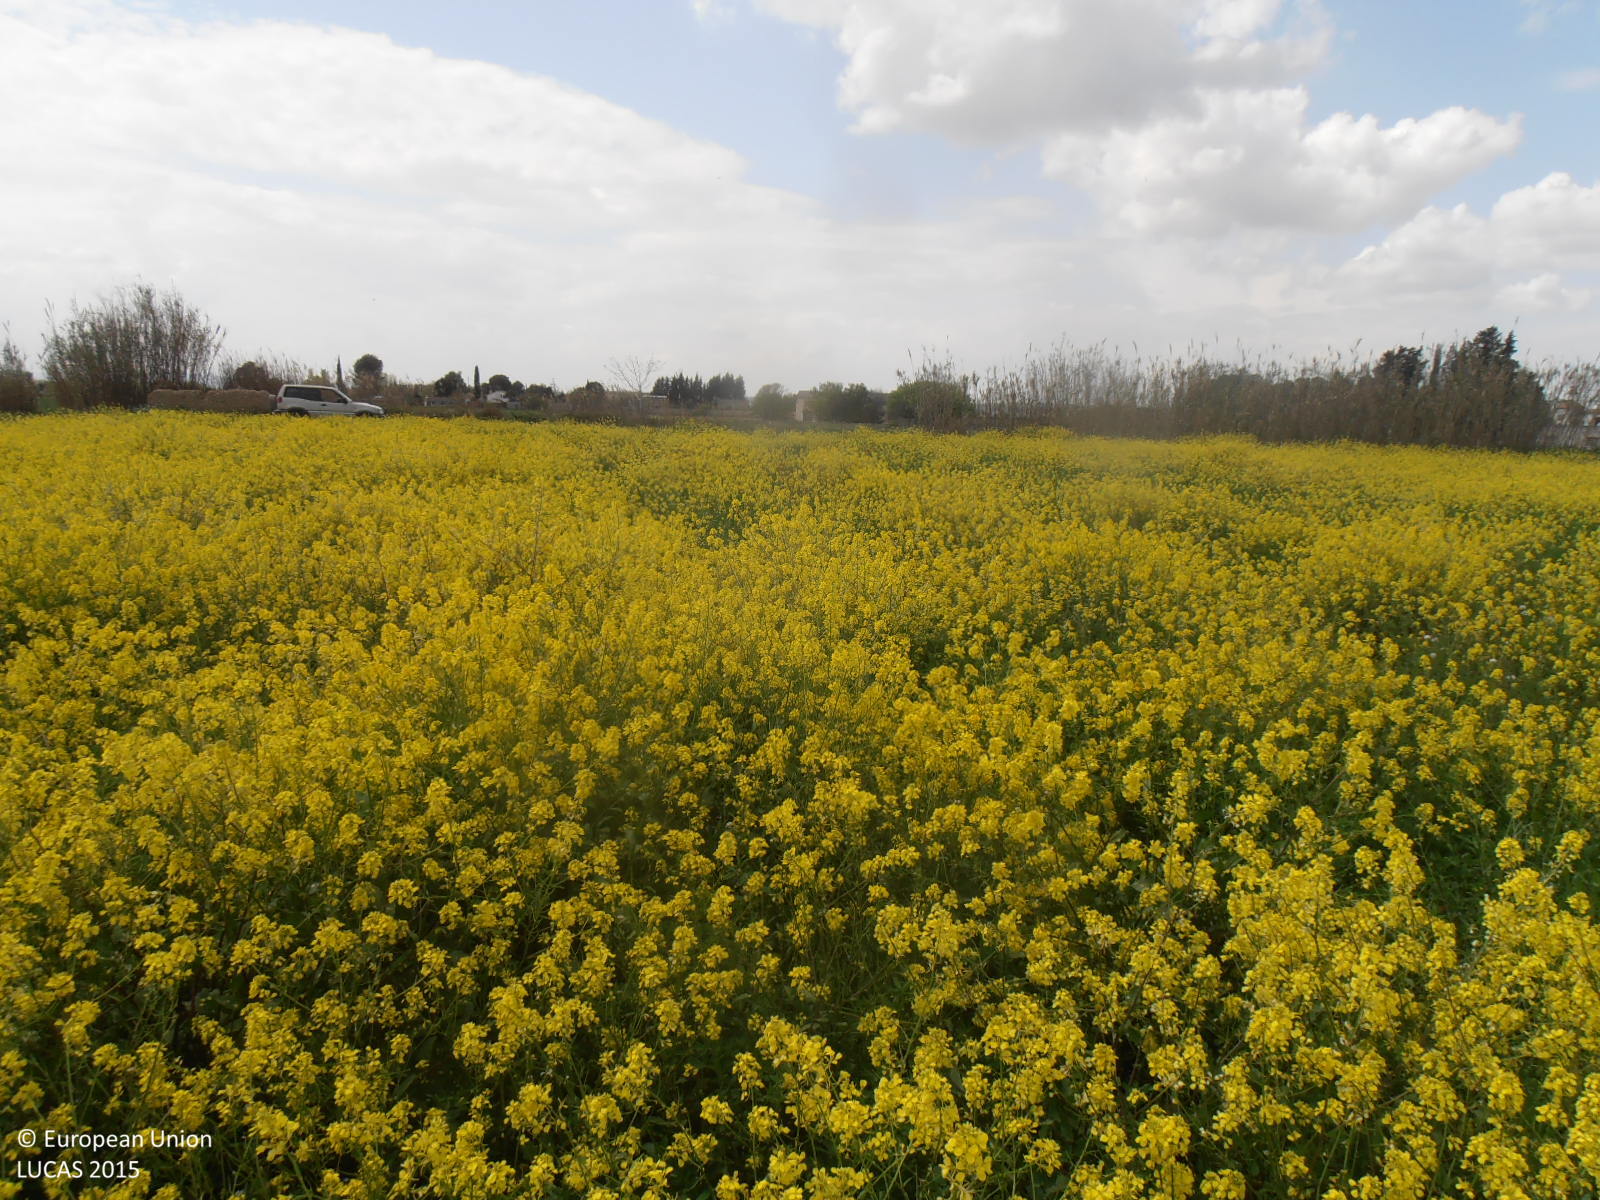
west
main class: Cropland
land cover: Rape and turnip rape
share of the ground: > 75 %
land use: Agriculture (excluding fallow land and kitchen gardens)
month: April
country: ES
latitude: 41.7104
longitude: -0.8023
